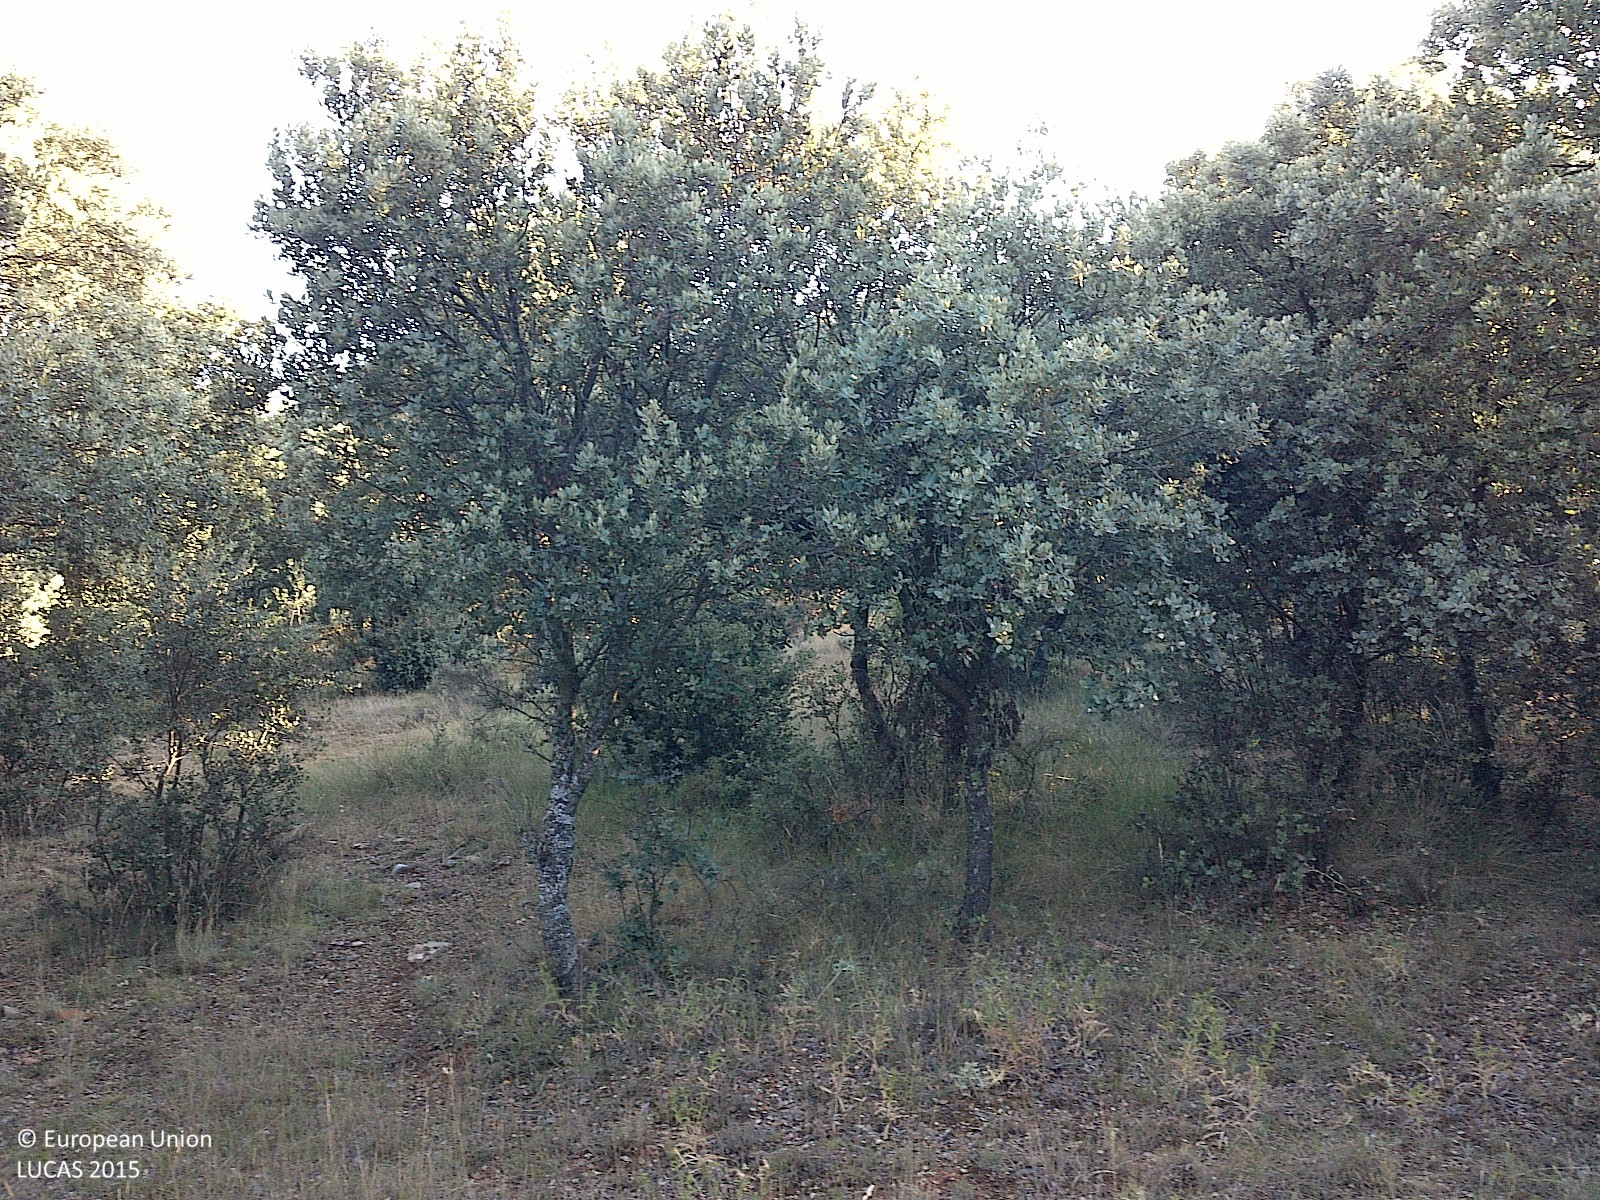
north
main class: Woodland
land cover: Broadleaved woodland
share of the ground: > 75 %
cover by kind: broadleaved forest trees 80 %, herbaceous plants 15 %, shrubs 5 %
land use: Forestry
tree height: < 5 m
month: July
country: ES
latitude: 41.7790
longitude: -1.9555
